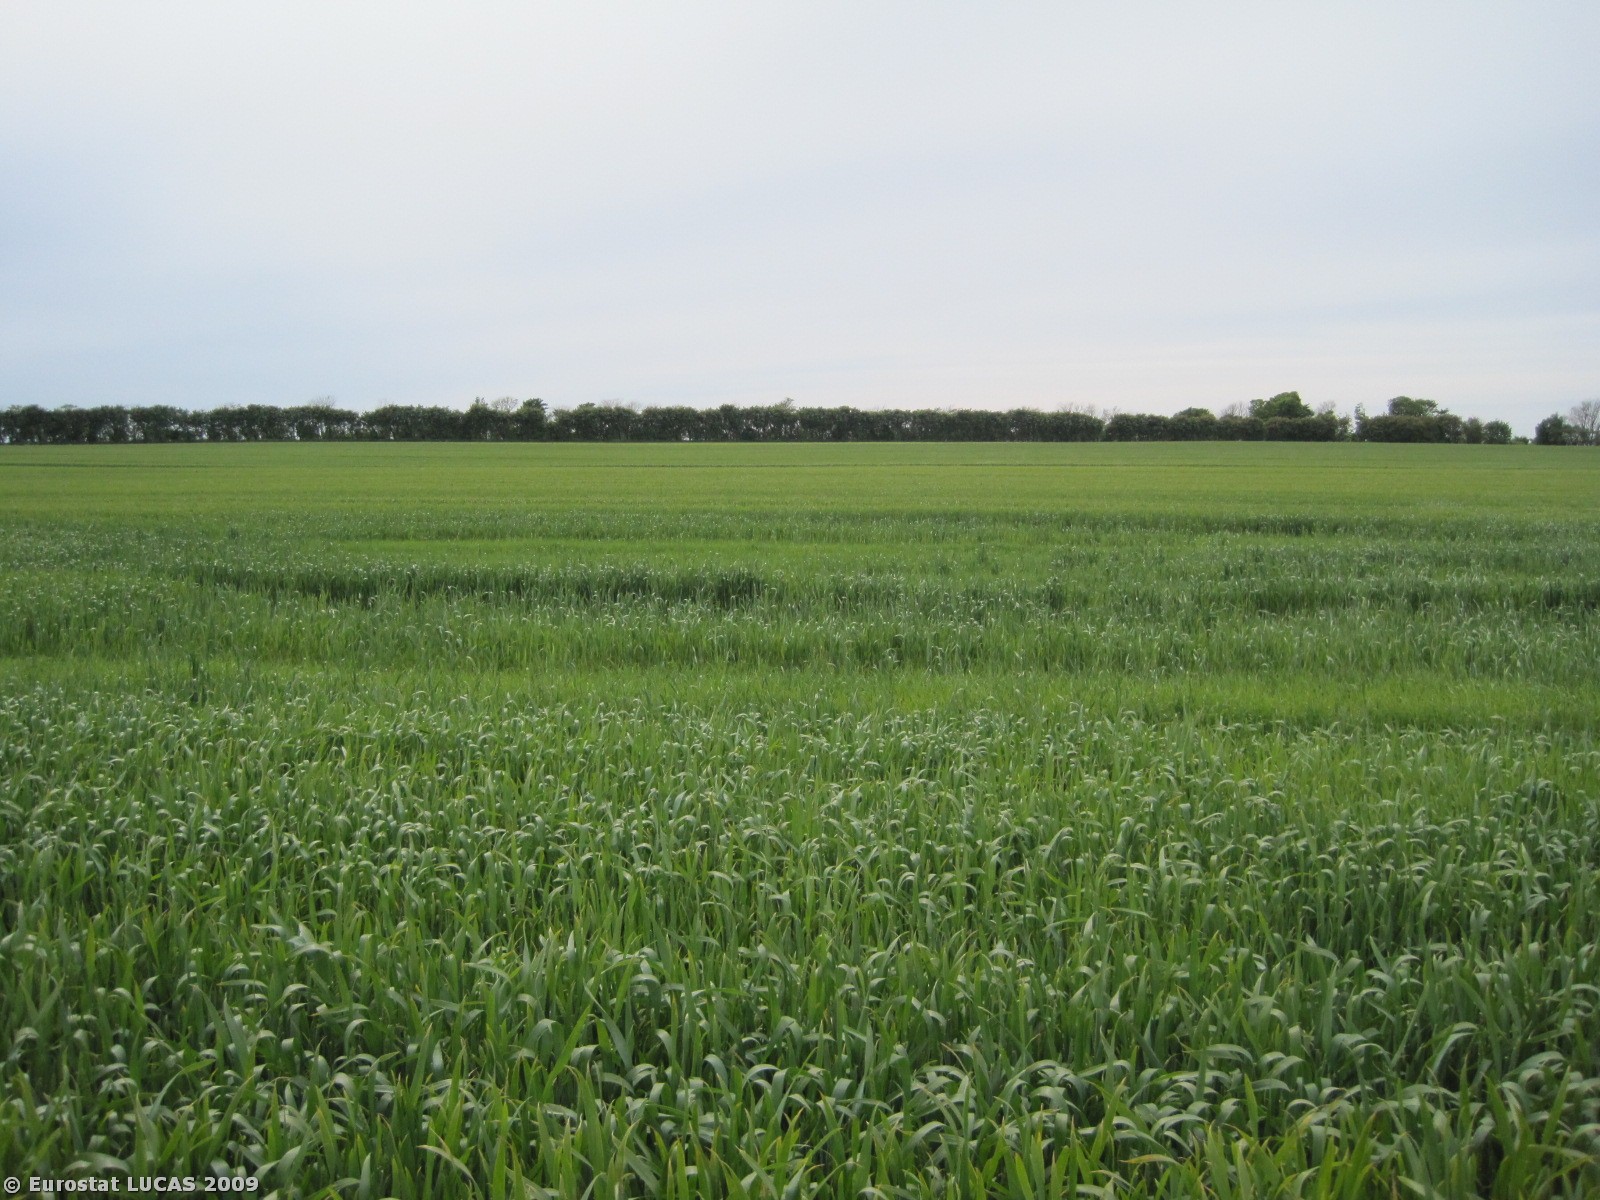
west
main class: Cropland
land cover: Common wheat
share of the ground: > 75 %
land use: Agriculture (excluding fallow land and kitchen gardens)
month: June
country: DK
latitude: 57.3743
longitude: 9.9834
